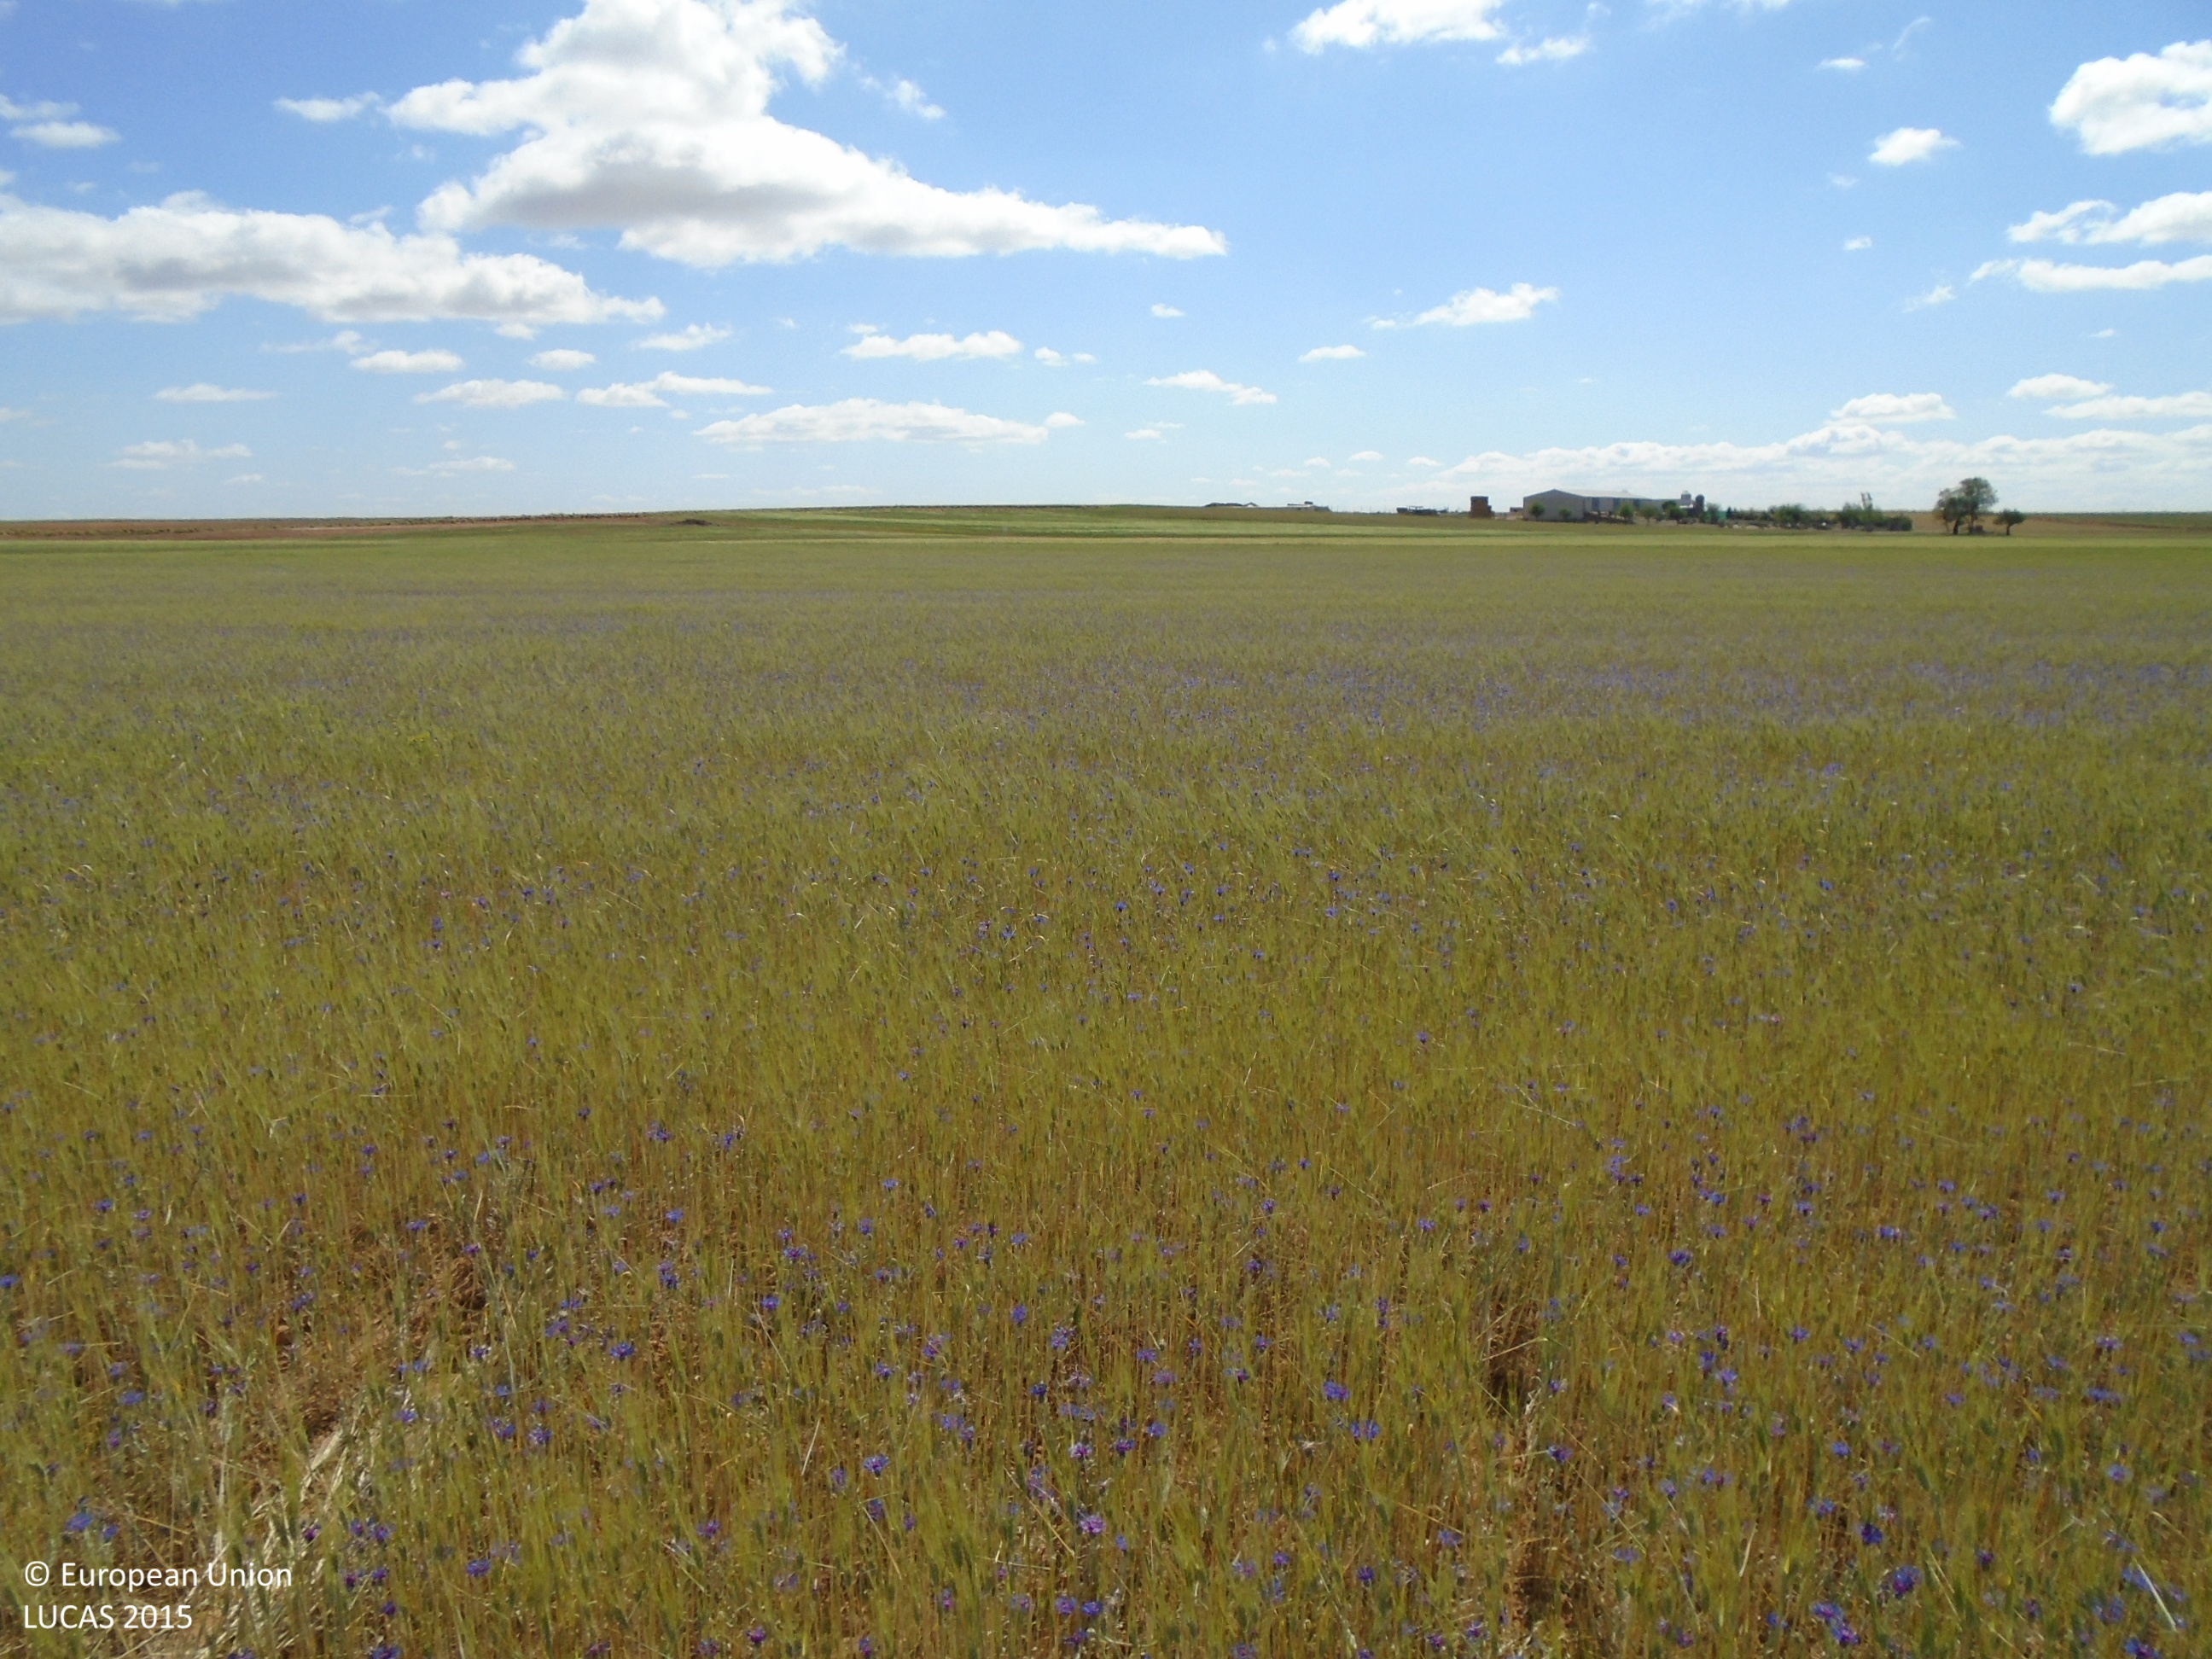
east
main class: Cropland
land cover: Vineyards
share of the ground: 10 - 25 %
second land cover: Other bare soil
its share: > 75 %
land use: Agriculture (excluding fallow land and kitchen gardens)
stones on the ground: < 10 %
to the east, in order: Vineyards; Other bare soil; Grass margins; Barley; Grass margins; Barley; Grass margins; Barley; Grass margins; Tracks; Barley
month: May
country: ES
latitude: 39.5592
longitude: -3.5602
